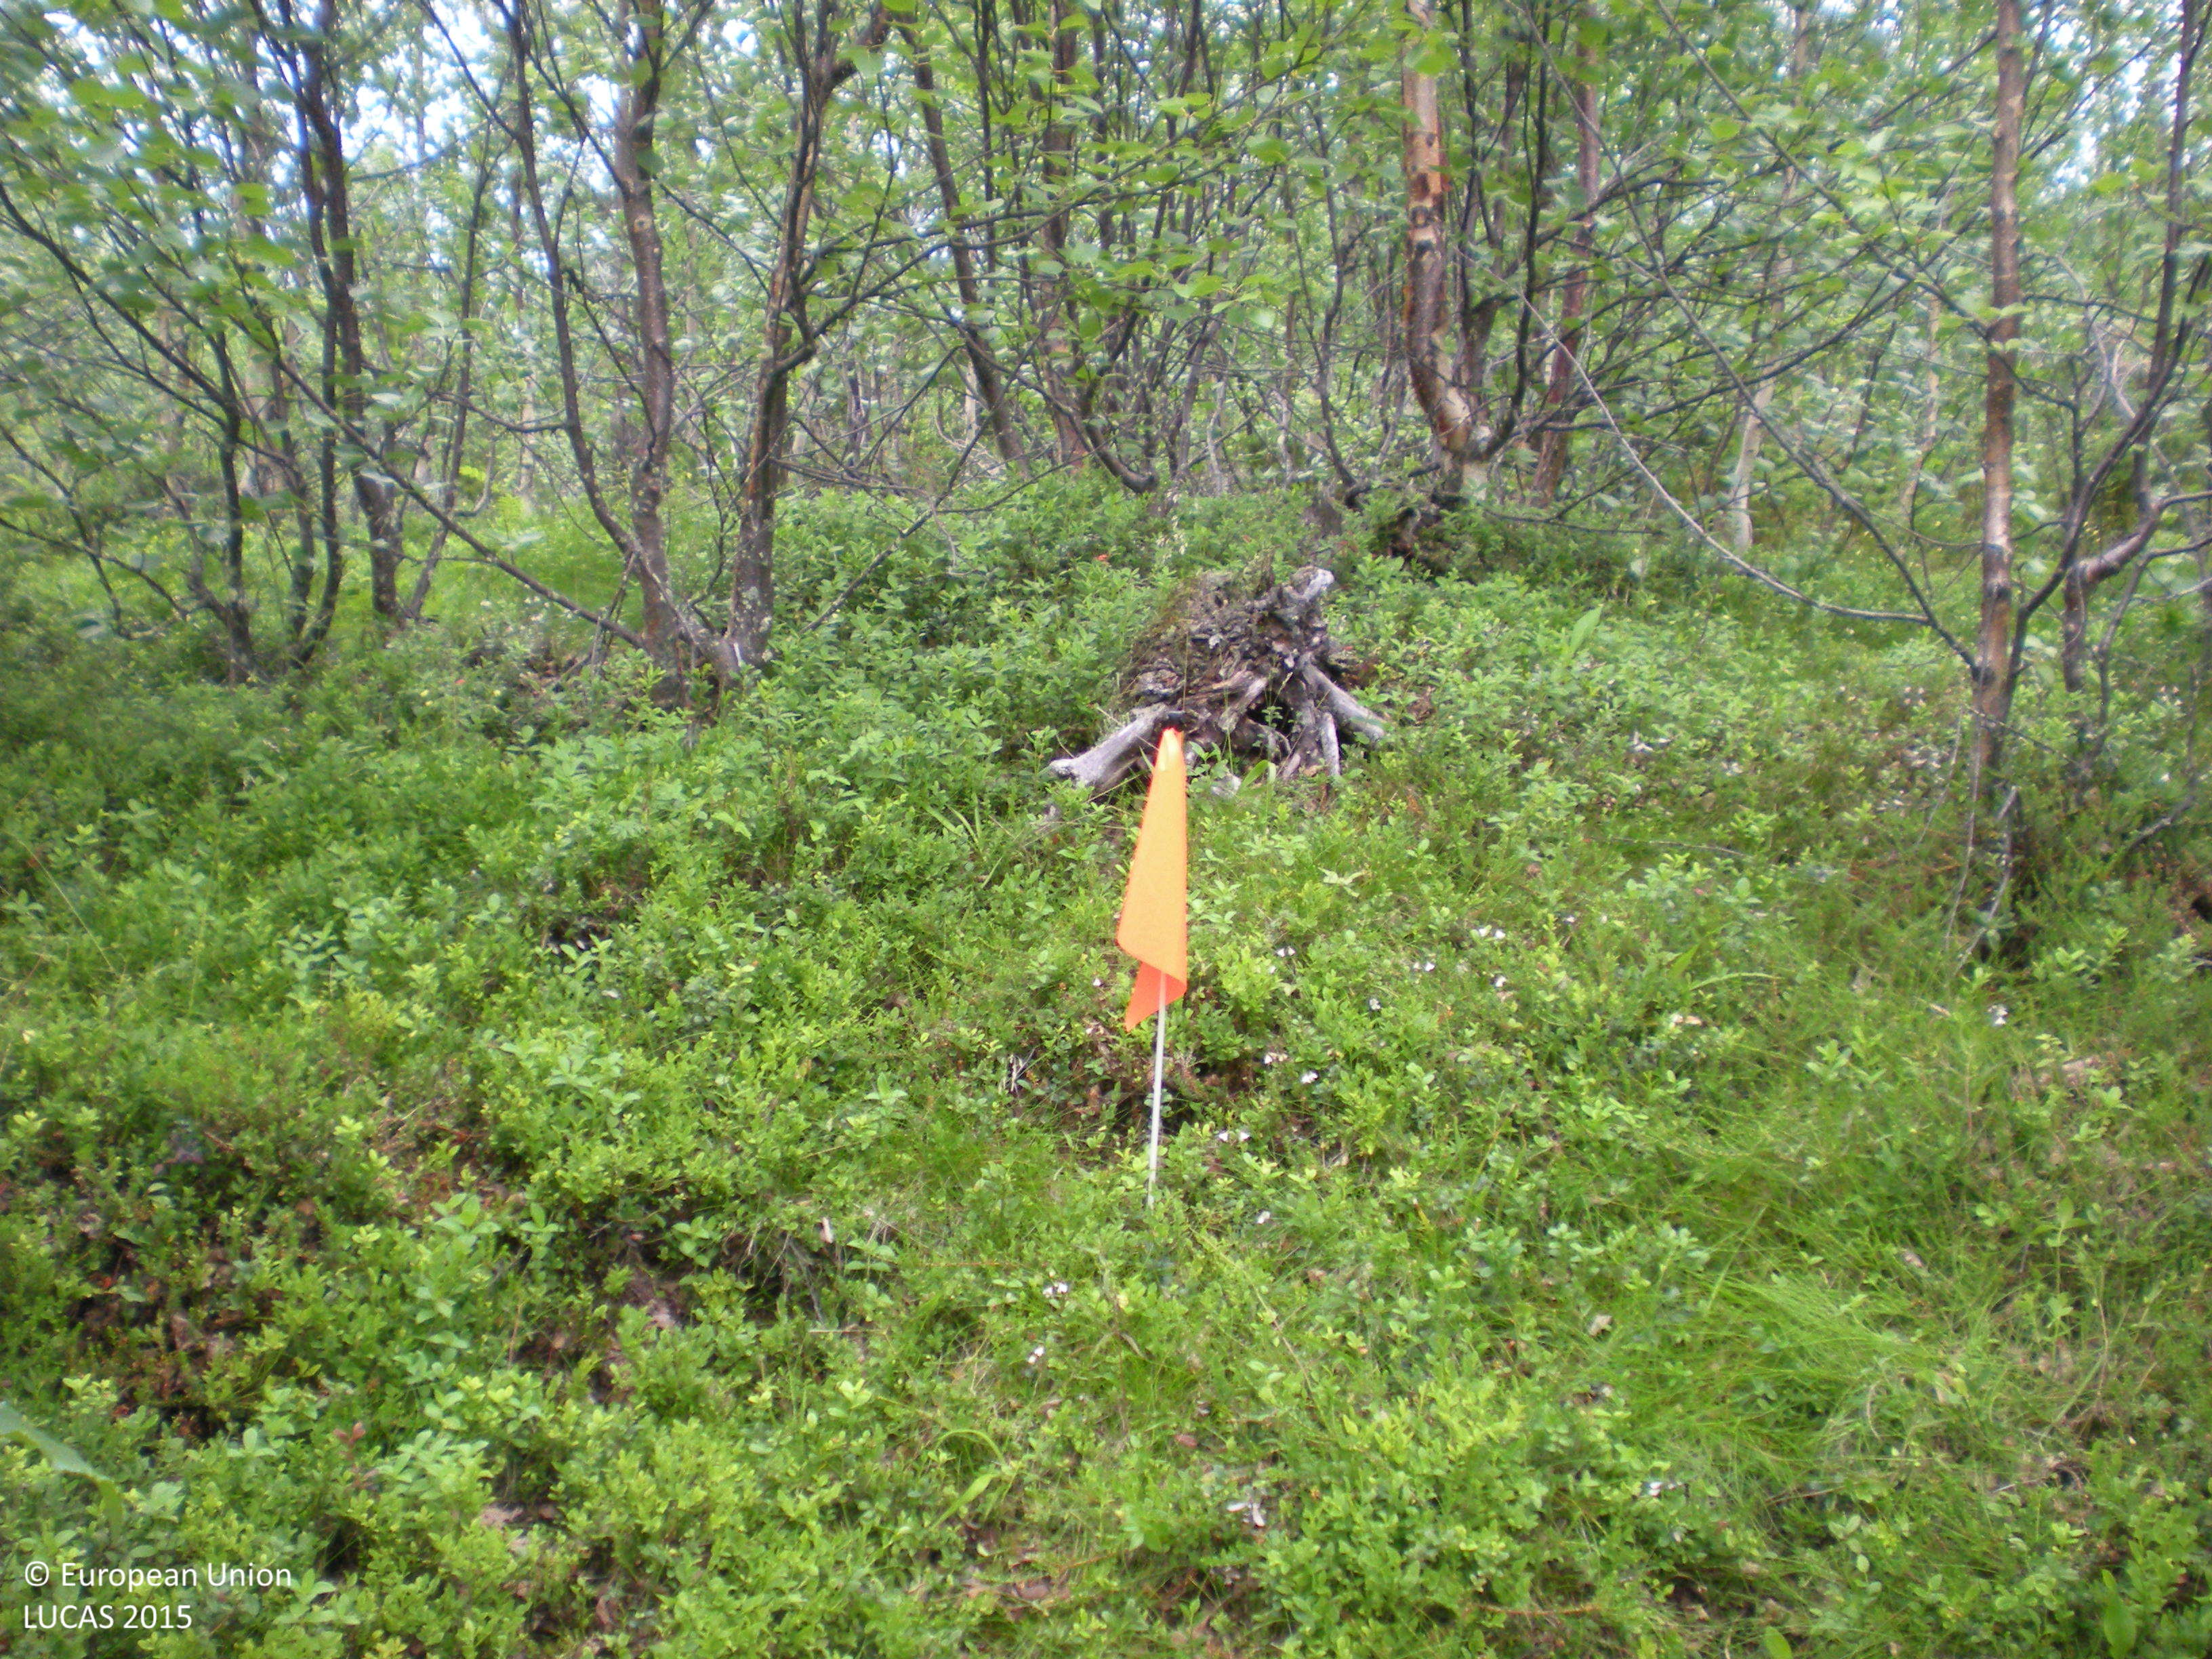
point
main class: Woodland
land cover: Broadleaved woodland
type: boreal forest
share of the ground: 50 - 75 %
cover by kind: broadleaved forest trees 65 %, herbaceous plants 20 %, shrubs 10 %, lichens and mosses 5 %
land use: Forestry
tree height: < 5 m
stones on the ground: > 50 %
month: August
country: SE
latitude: 66.2613
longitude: 17.3670
